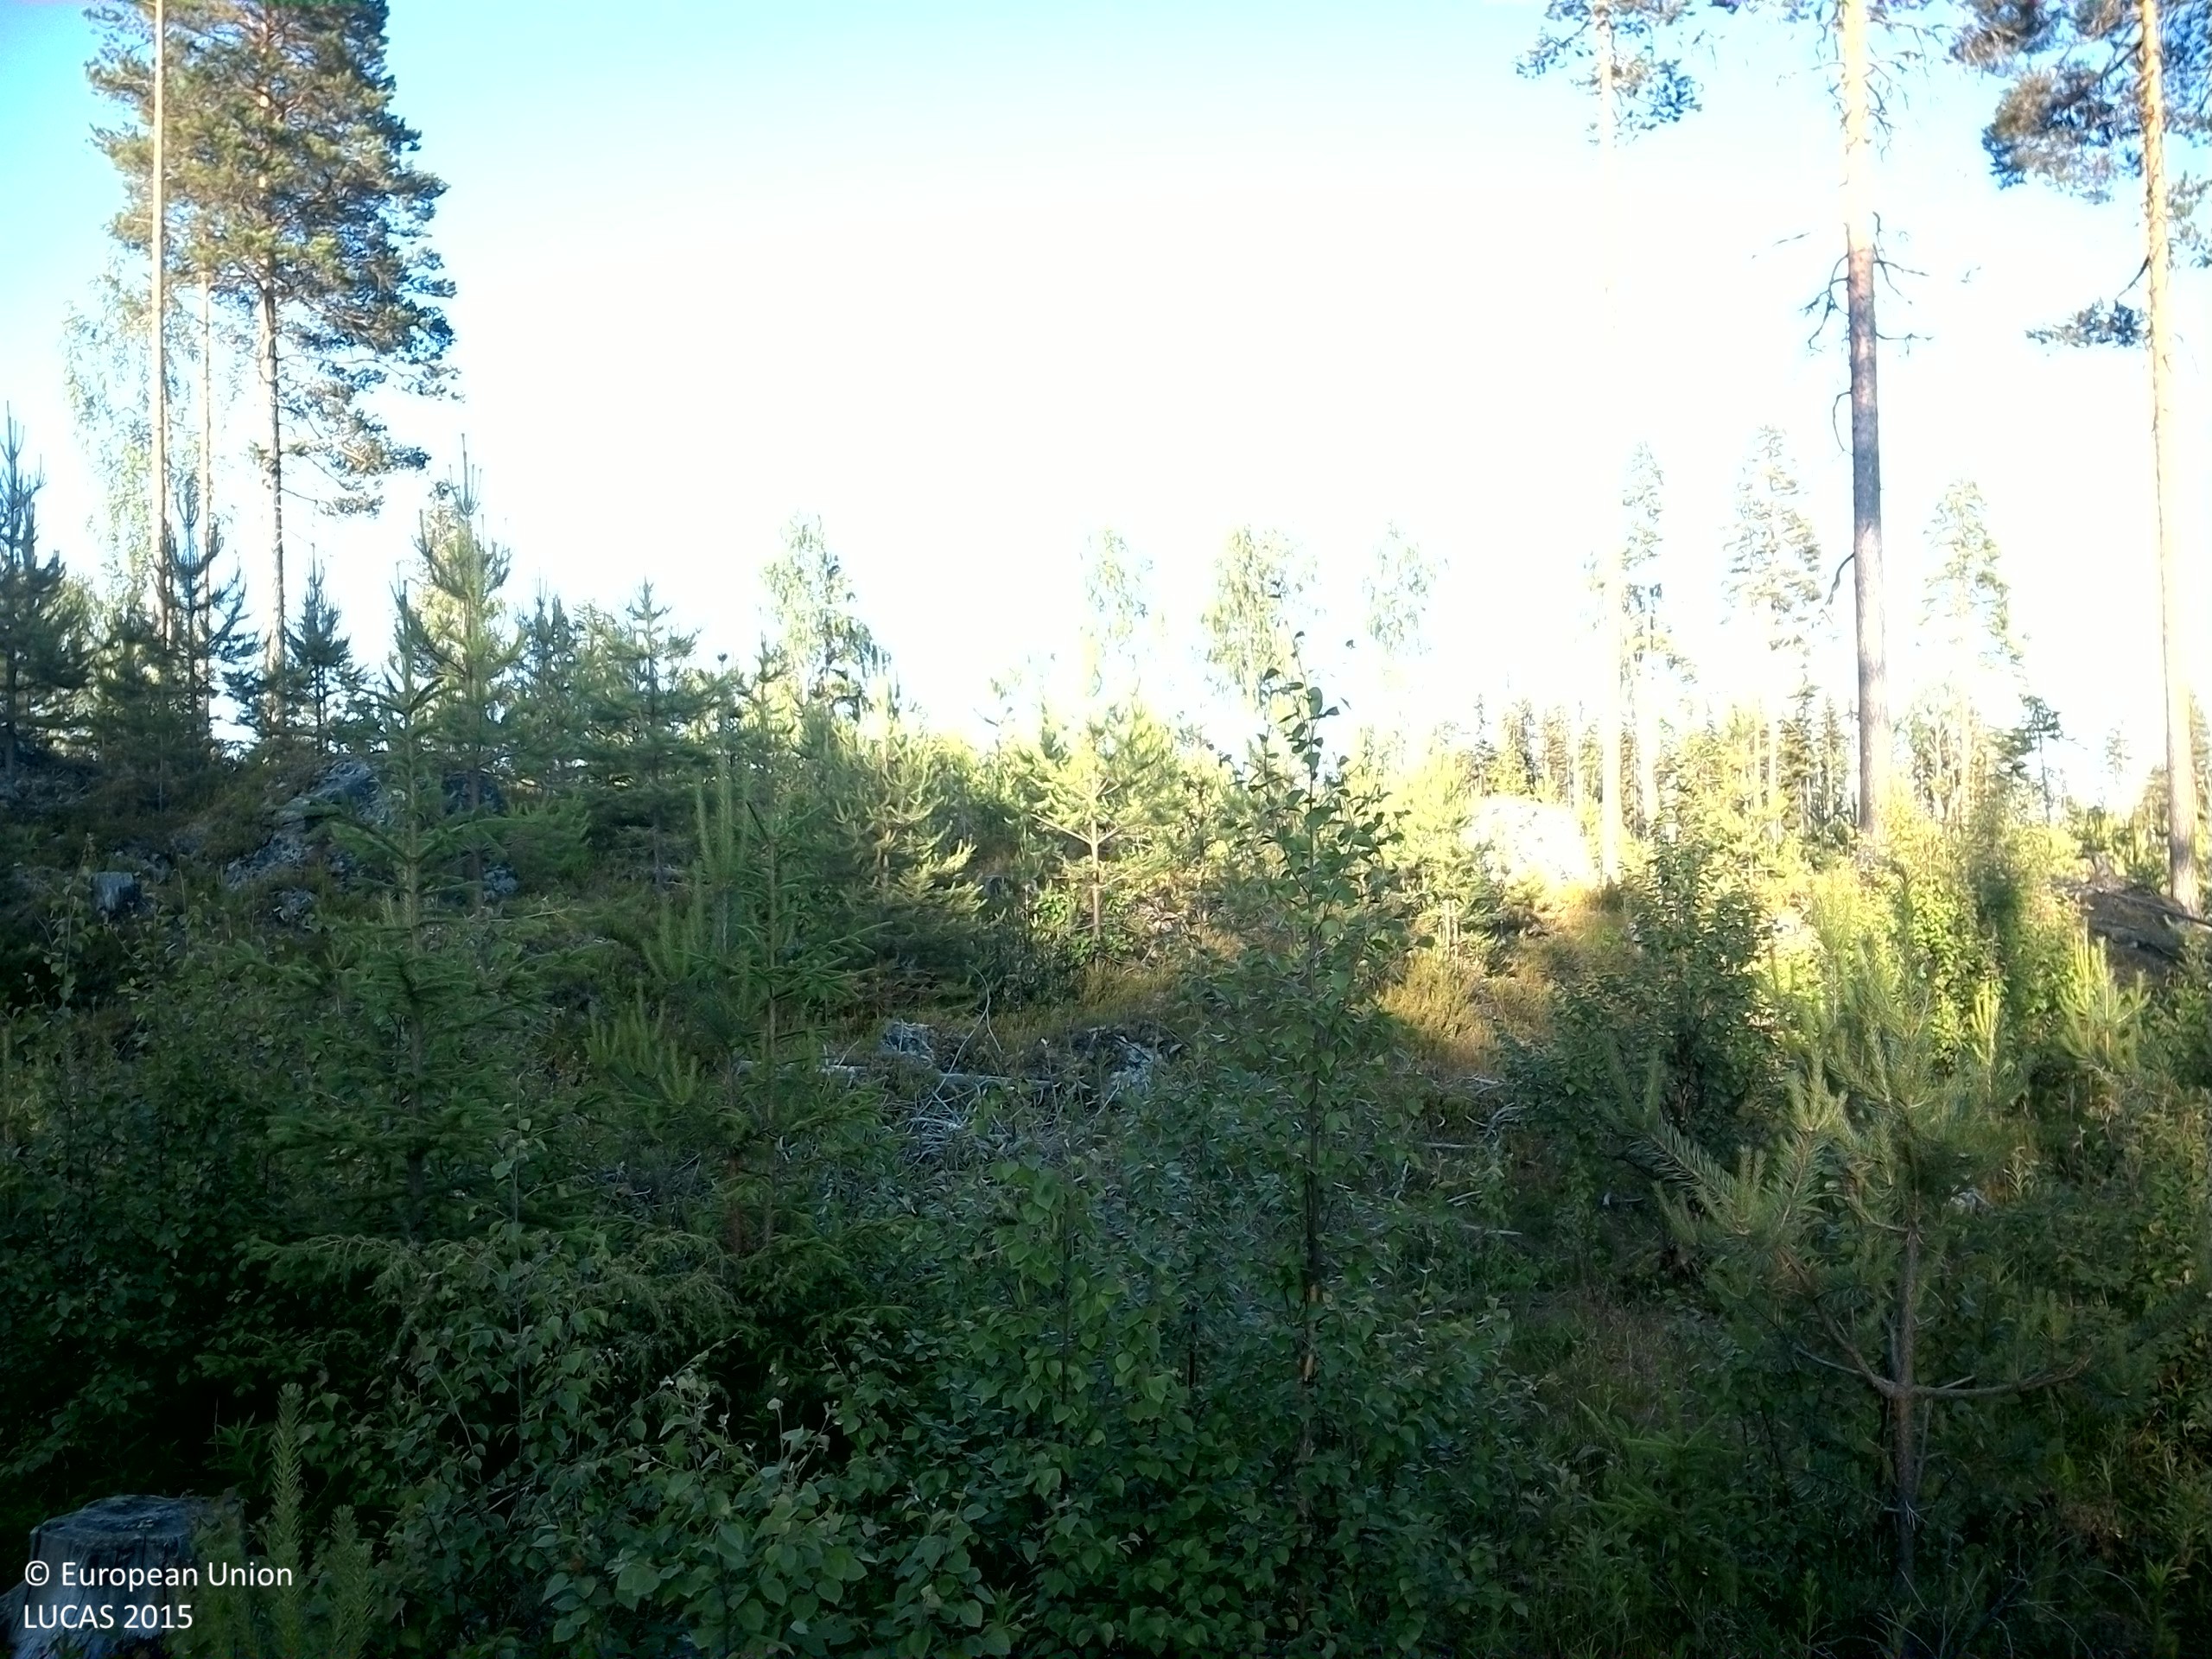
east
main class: Woodland
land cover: Pine dominated mixed woodland
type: boreal forest
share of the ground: 50 - 75 %
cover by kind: coniferous forest trees 45 %, herbaceous plants 20 %, broadleaved forest trees 15 %, shrubs 10 %, lichens and mosses 10 %
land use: Forestry
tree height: < 5 m
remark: Clear cut
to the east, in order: Pine dominated mixed woodland; Broadleaved woodland; Pine dominated mixed woodland; Spruce dominated mixed woodland; Pine dominated mixed woodland; Pine dominated coniferous woodland
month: July
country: SE
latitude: 63.6560
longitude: 17.5472
